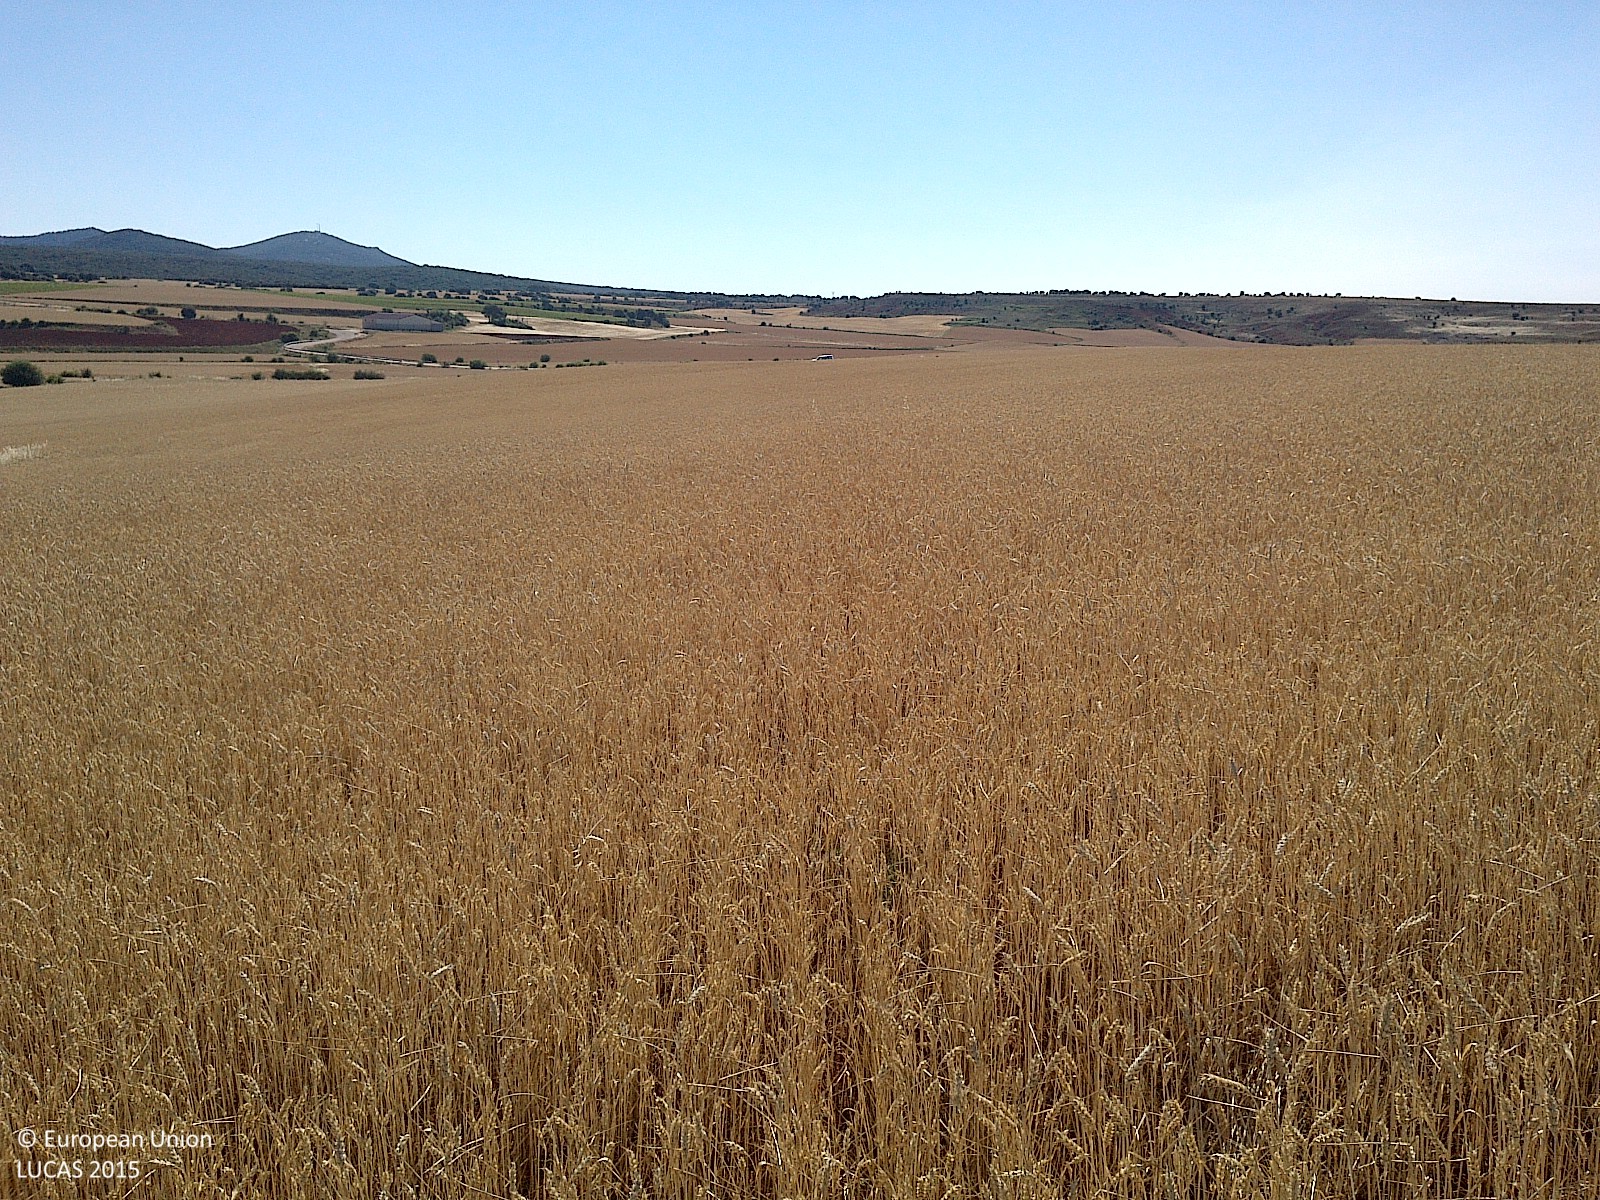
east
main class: Cropland
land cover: Common wheat
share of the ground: > 75 %
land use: Agriculture (excluding fallow land and kitchen gardens)
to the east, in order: Common wheat
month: July
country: ES
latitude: 41.6579
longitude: -2.7818
